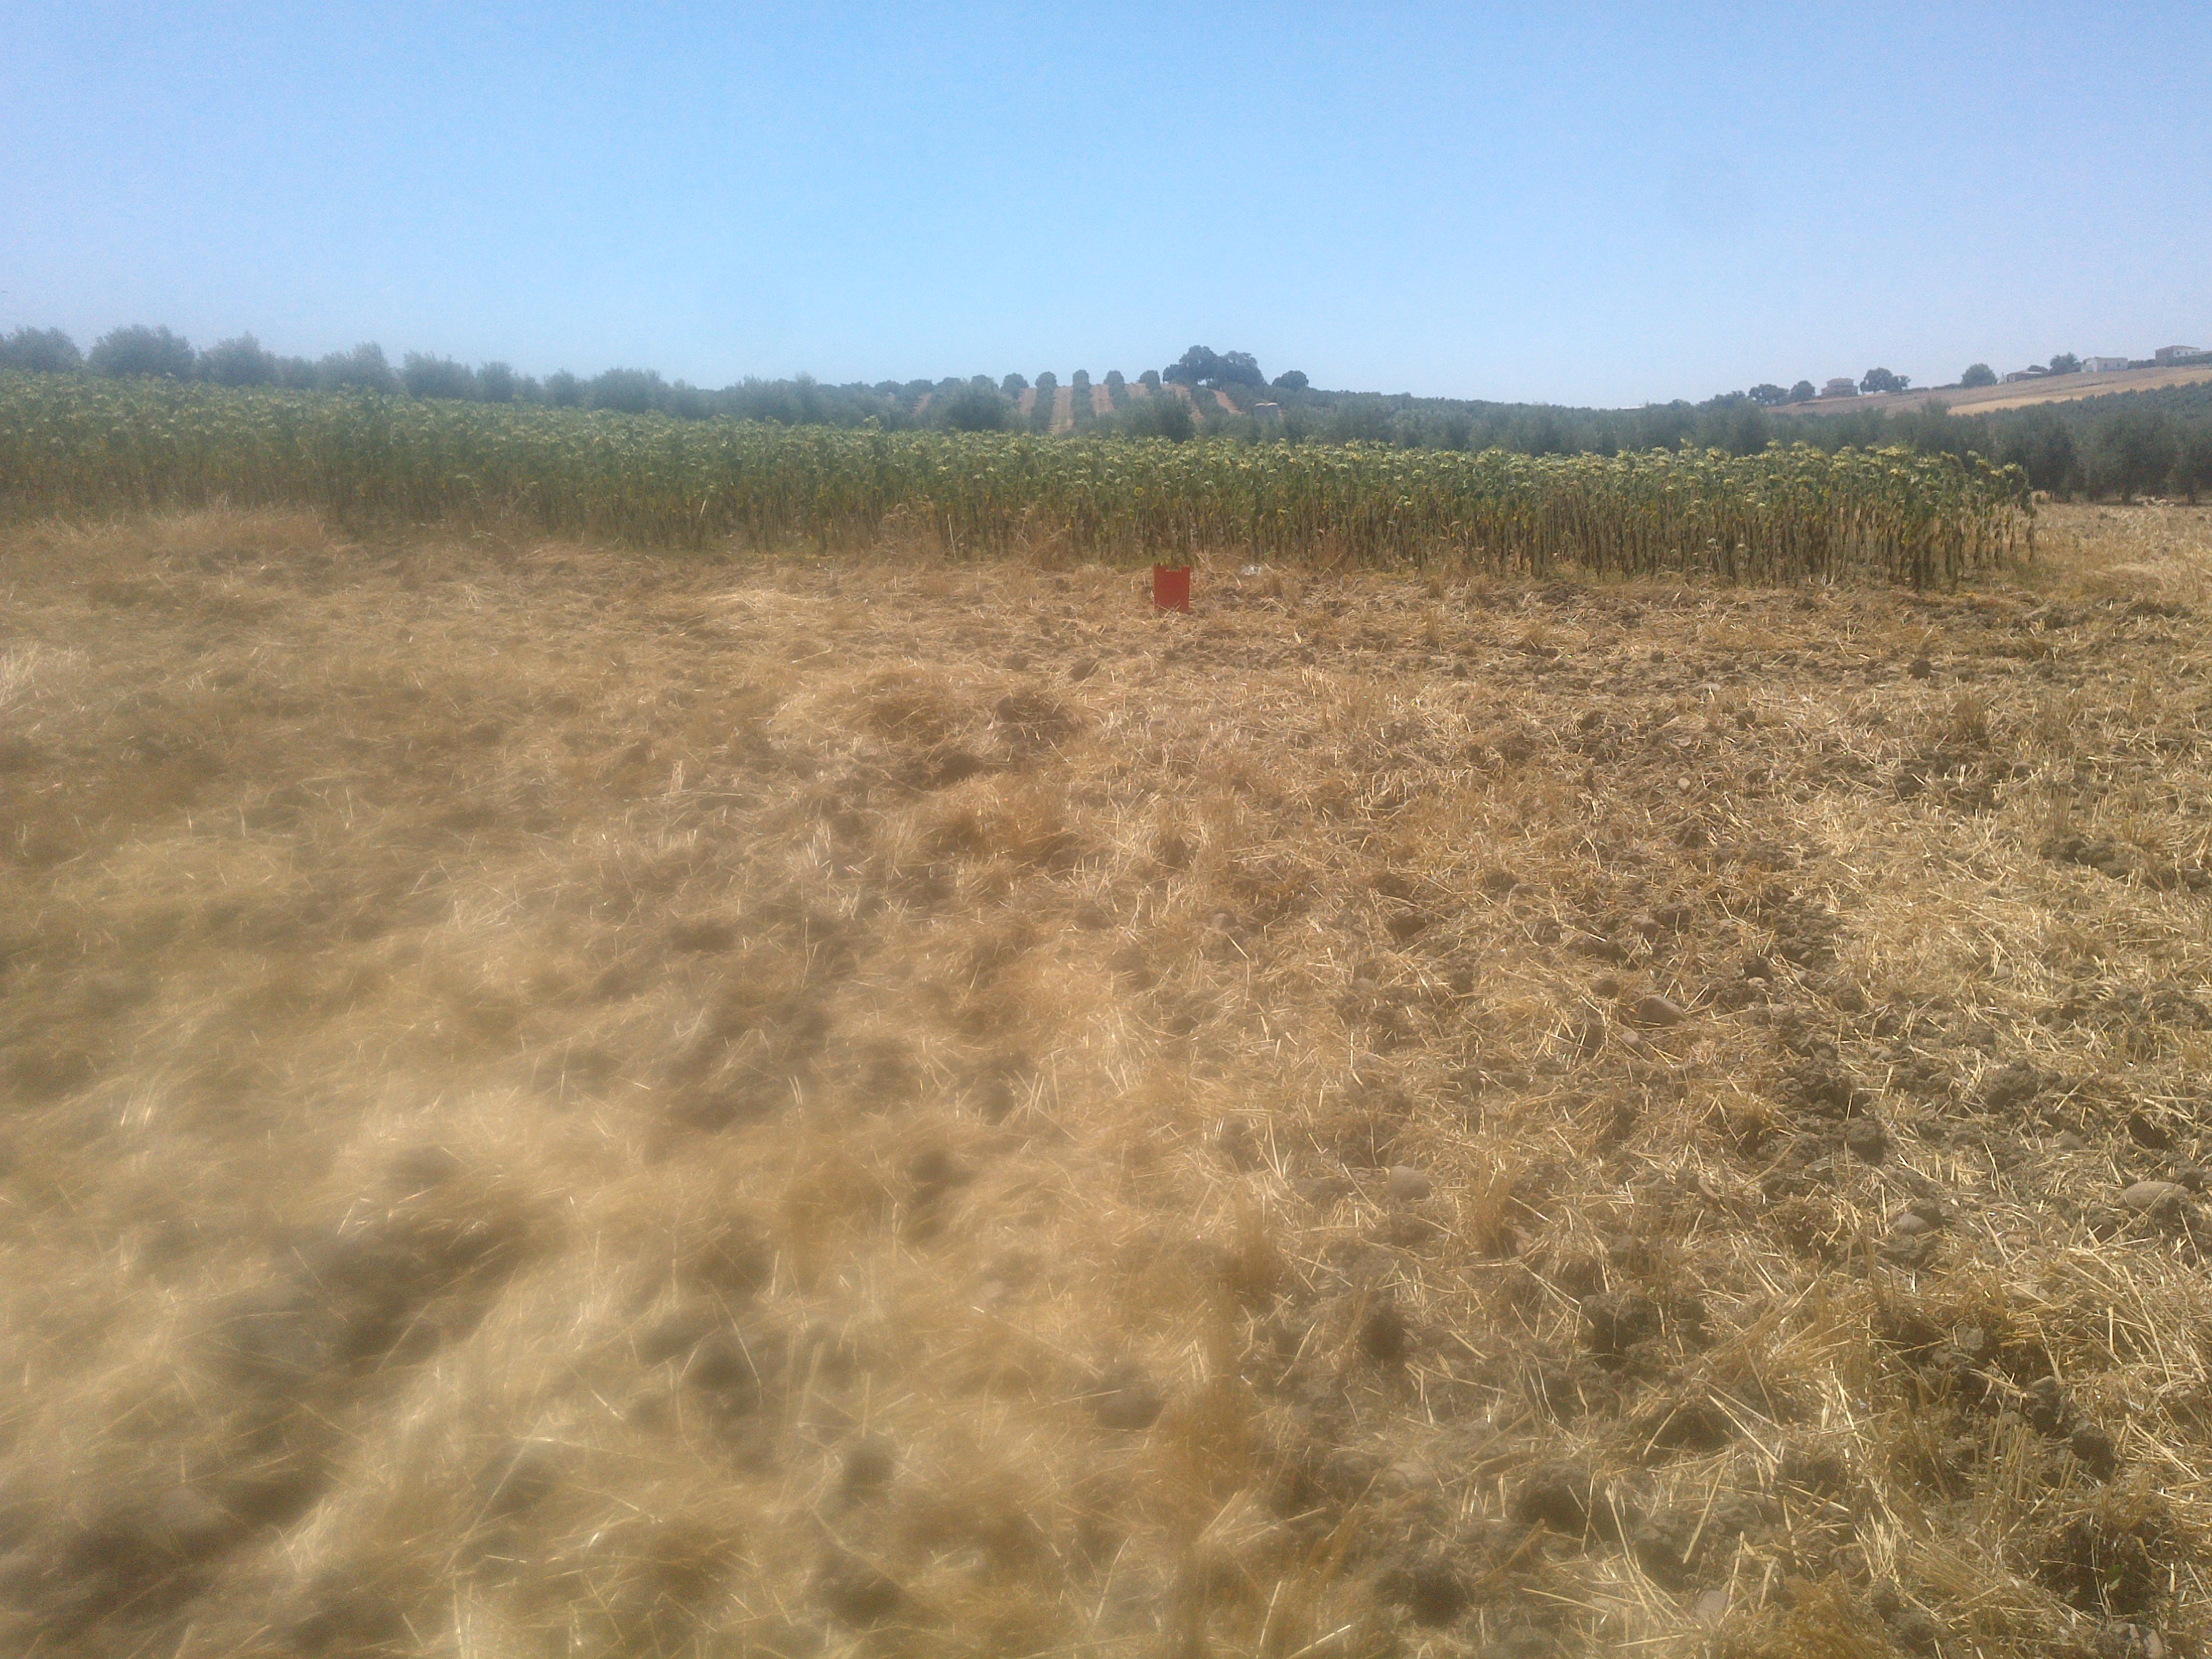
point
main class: Cropland
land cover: Durum wheat
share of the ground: < 10 %
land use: Agriculture (excluding fallow land and kitchen gardens)
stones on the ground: 10 - 25 %
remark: Harvested field
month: June
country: ES
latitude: 37.6708
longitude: -4.8984
